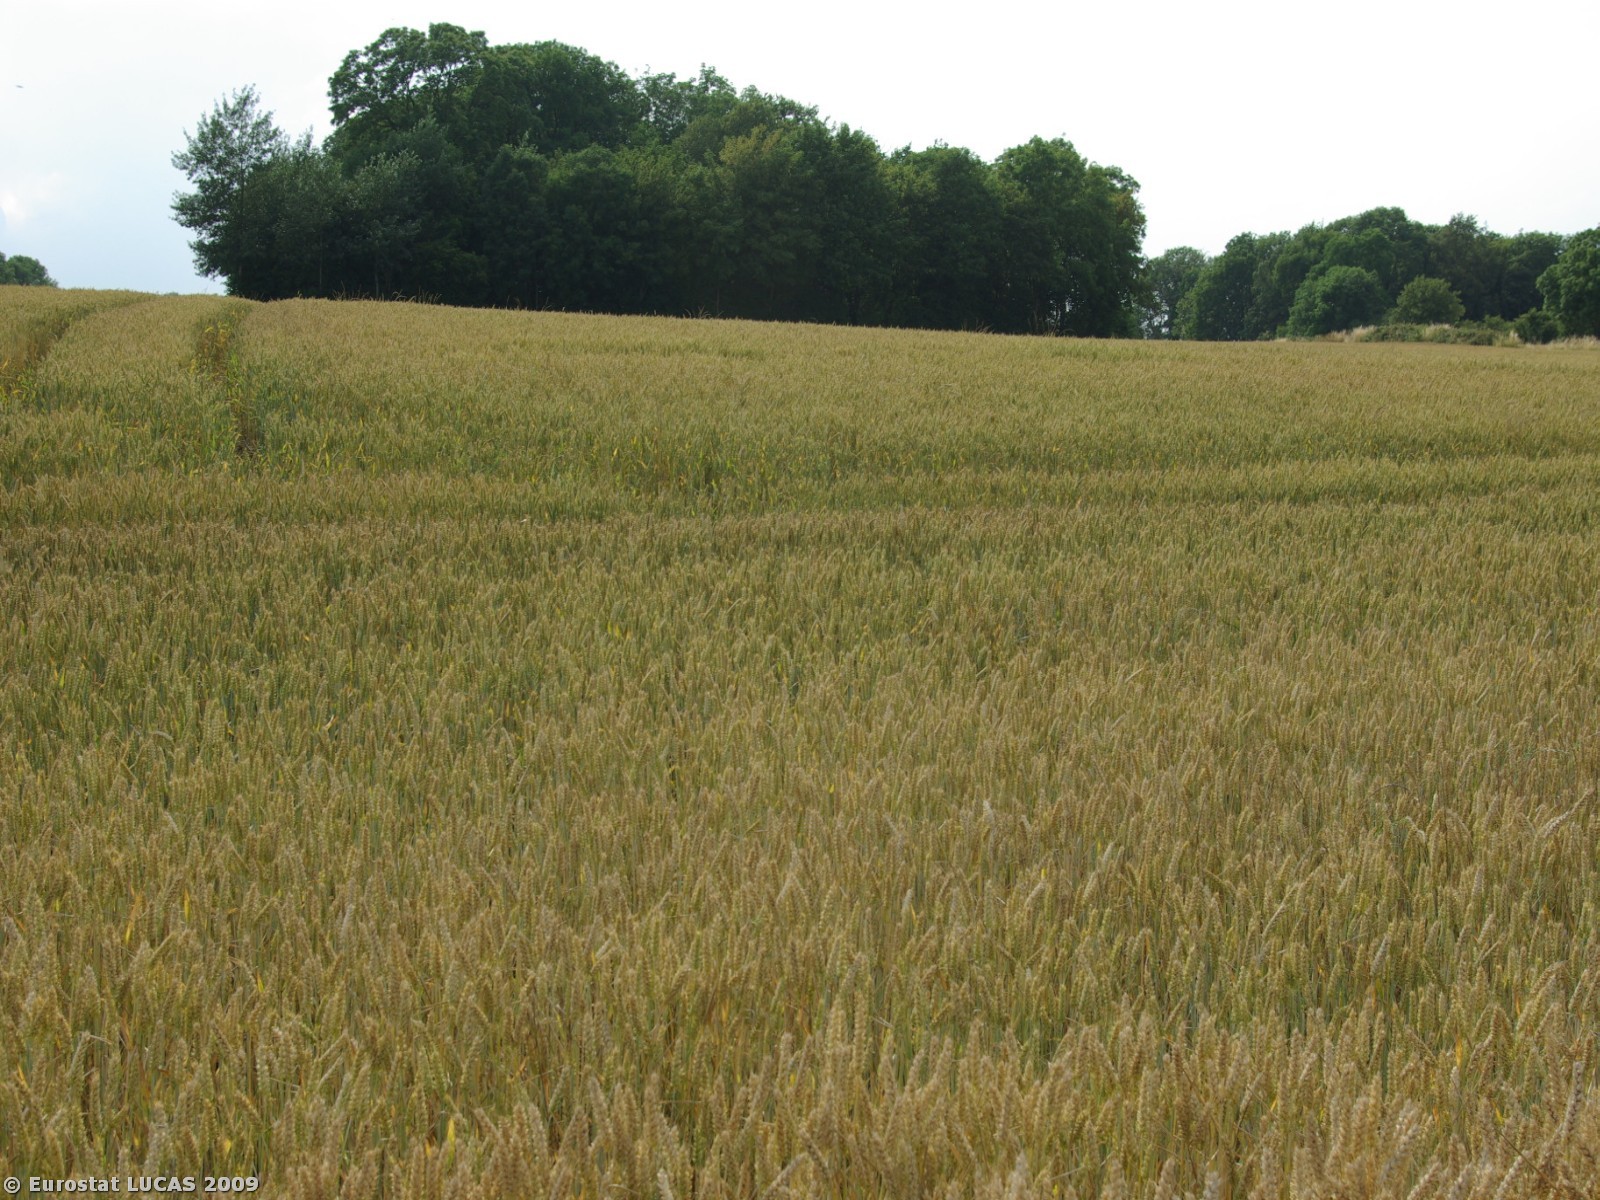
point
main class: Cropland
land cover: Common wheat
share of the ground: > 75 %
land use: Agriculture (excluding fallow land and kitchen gardens)
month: July
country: DK
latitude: 55.0373
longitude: 9.8593
